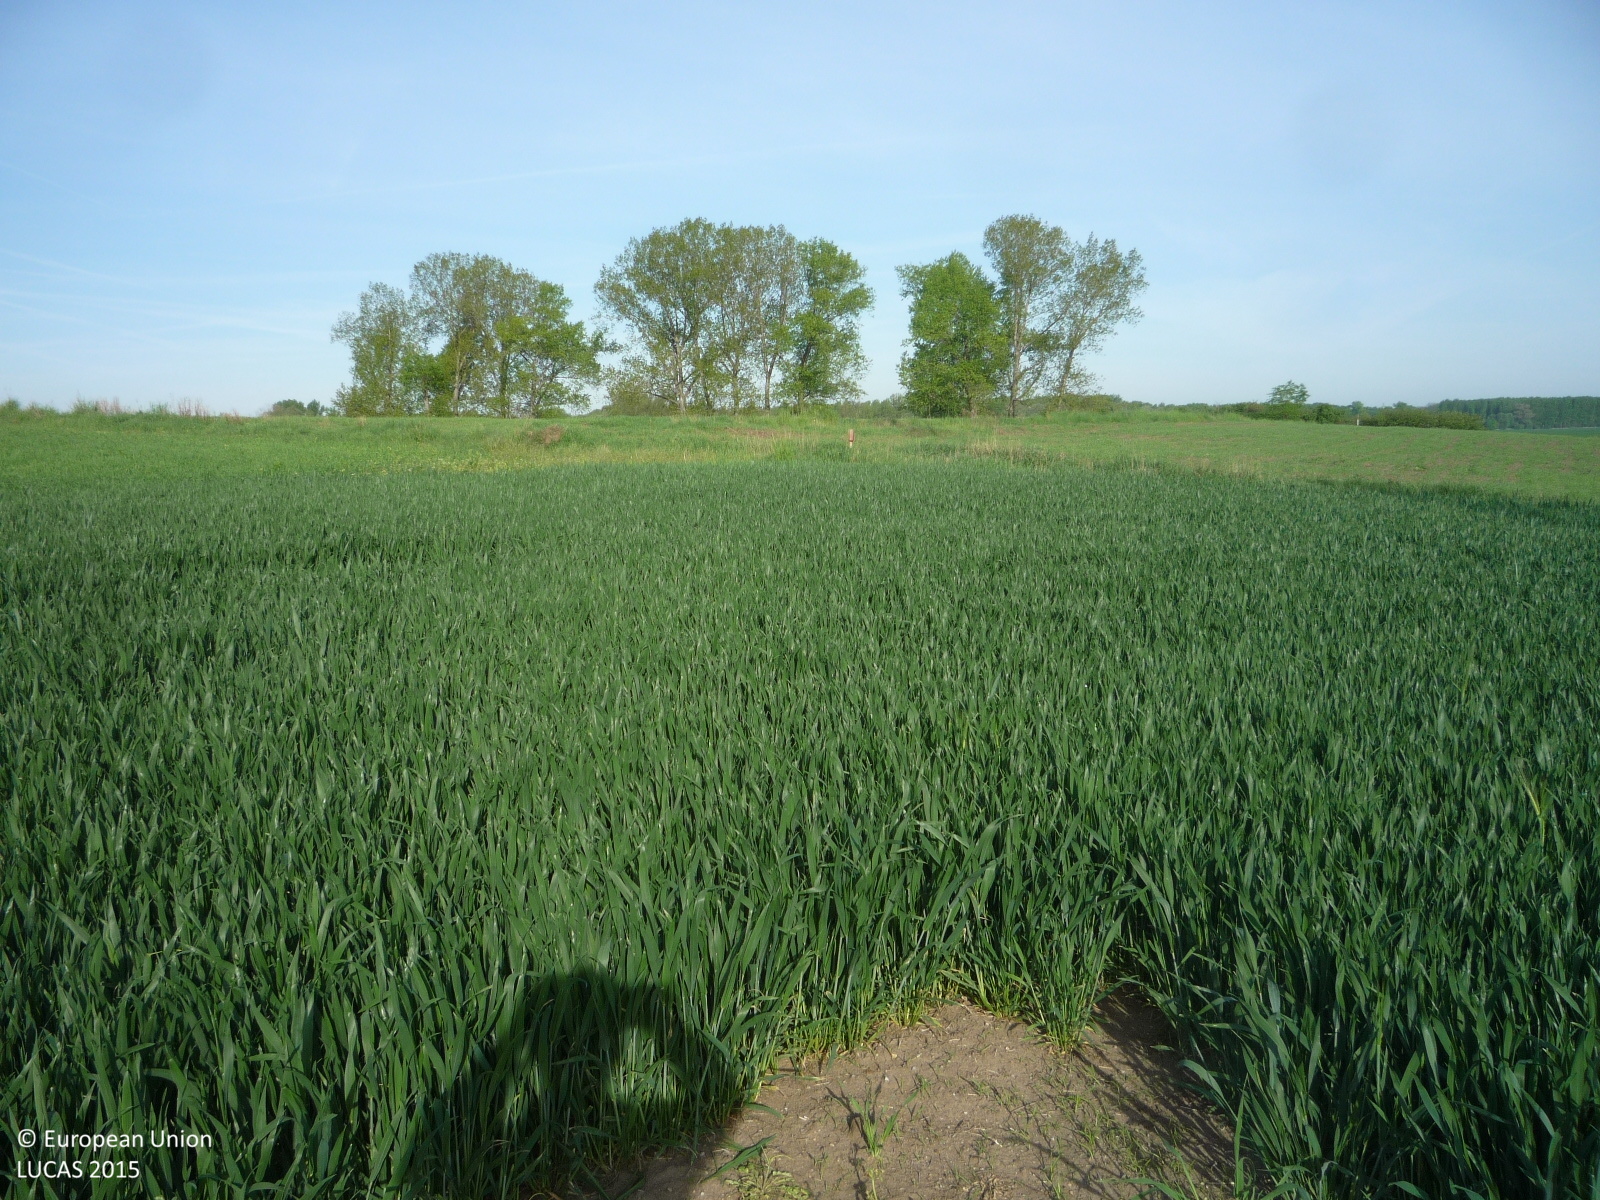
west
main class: Cropland
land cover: Common wheat
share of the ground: > 75 %
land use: Agriculture (excluding fallow land and kitchen gardens)
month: May
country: CZ
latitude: 50.3112
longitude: 14.5093
